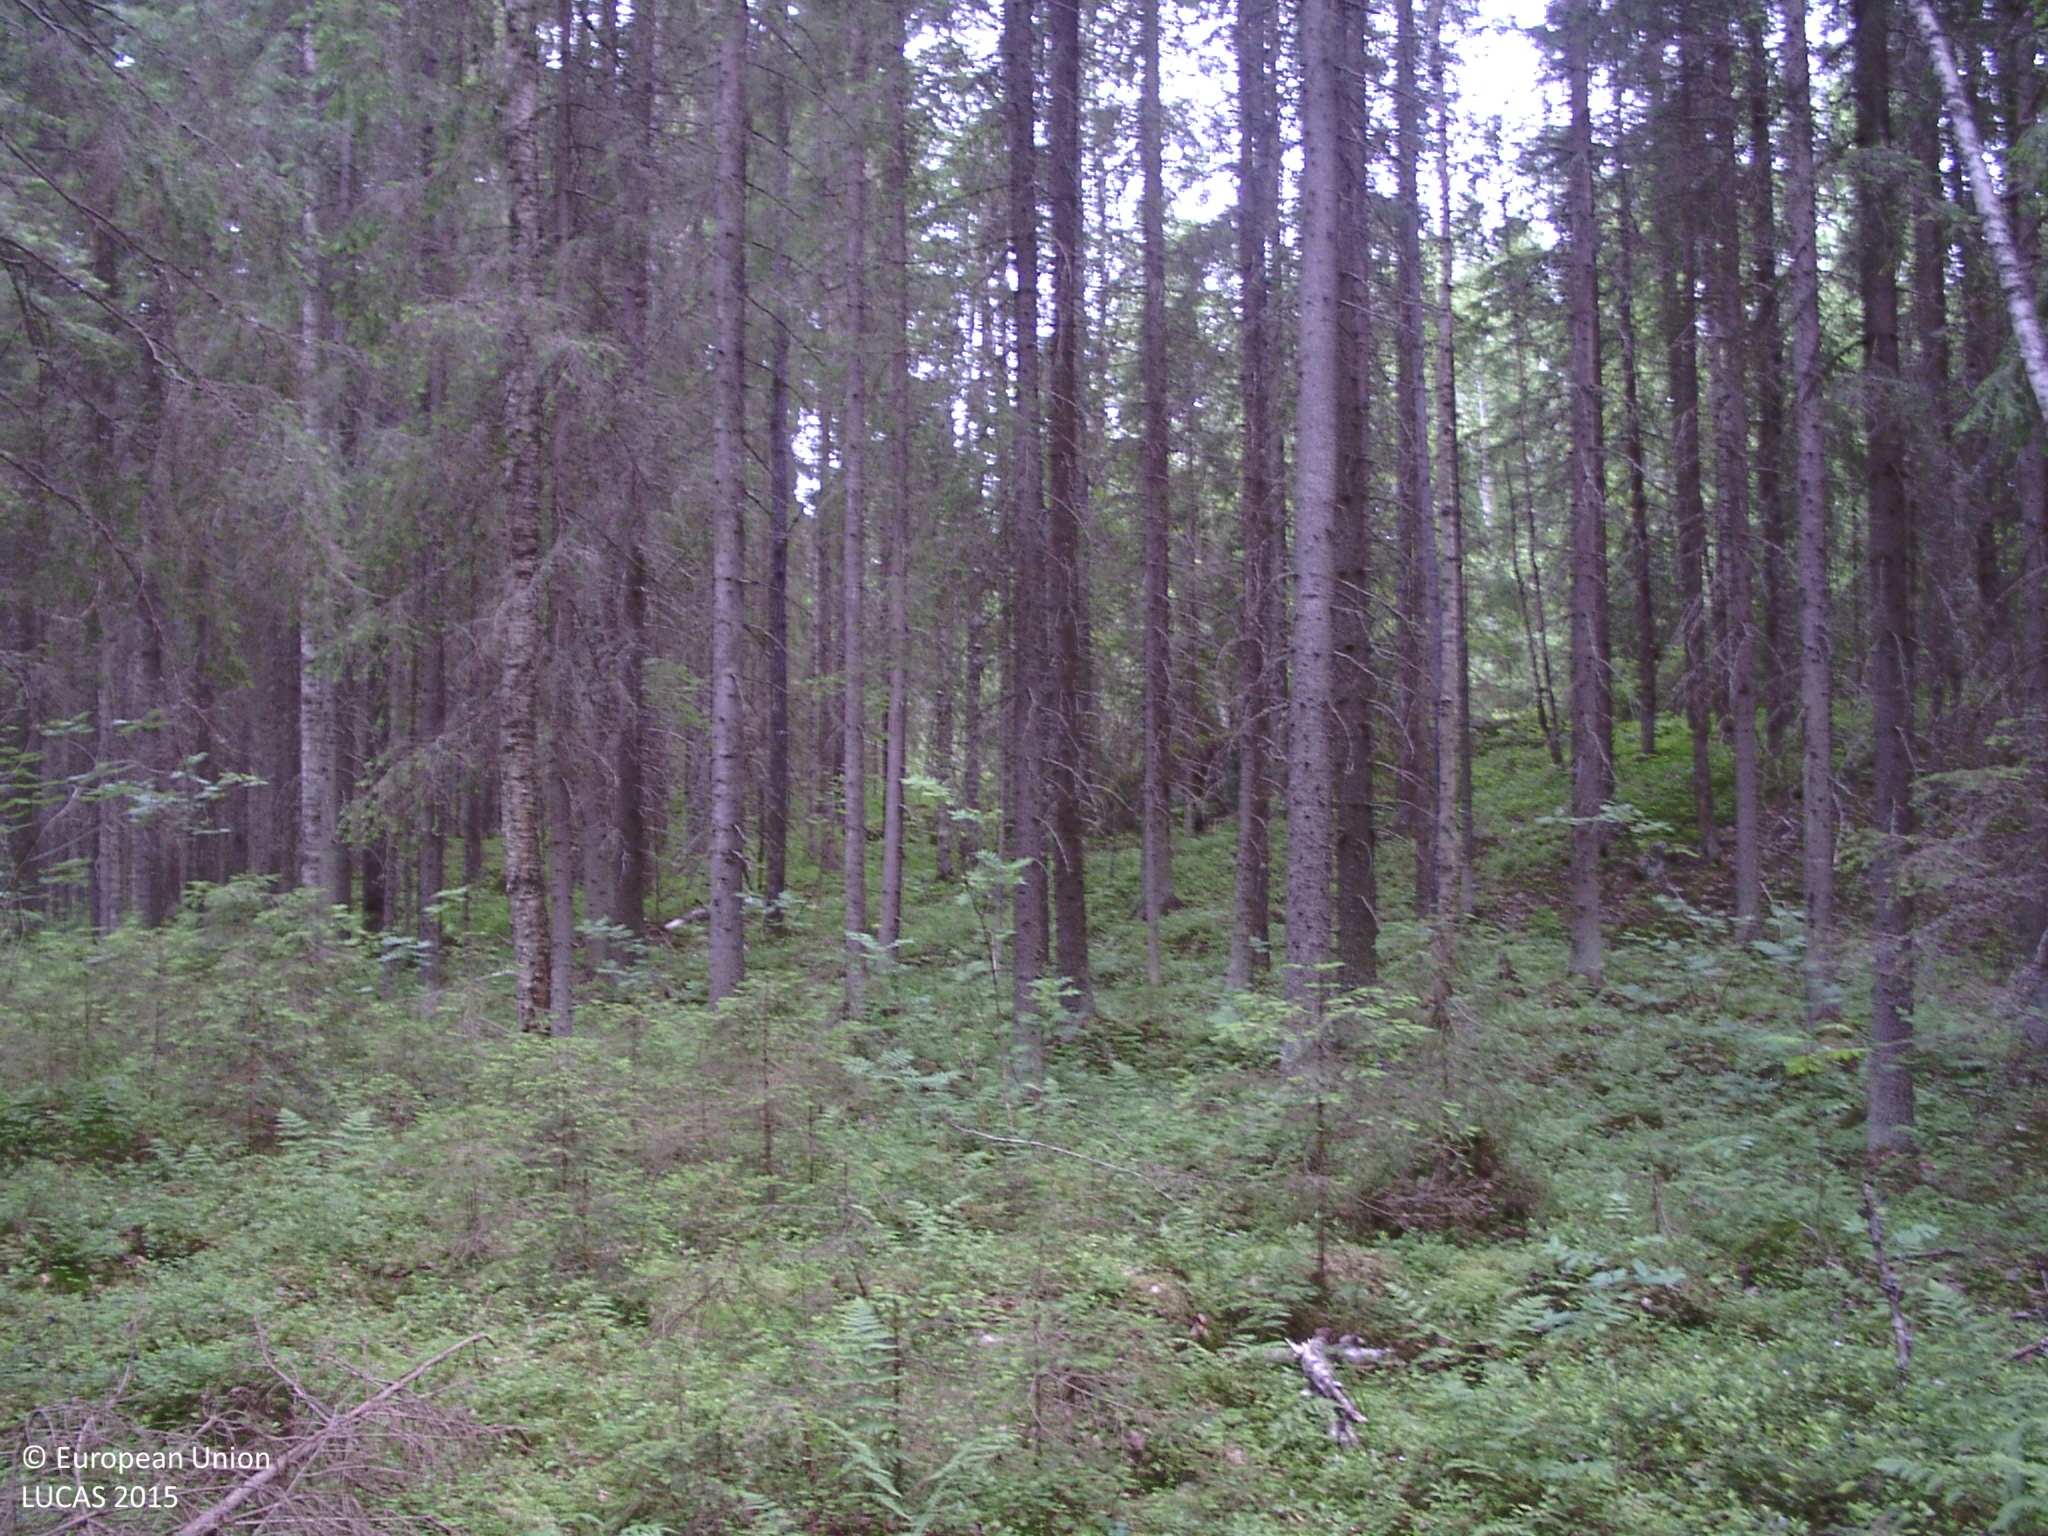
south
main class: Woodland
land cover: Spruce dominated coniferous woodland
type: boreal forest
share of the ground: > 75 %
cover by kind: coniferous forest trees 65 %, broadleaved forest trees 15 %, lichens and mosses 10 %, shrubs 5 %, herbaceous plants 5 %
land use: Semi-natural and natural areas not in use
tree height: > 5 m
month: June
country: FI
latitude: 62.0451
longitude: 25.1180
